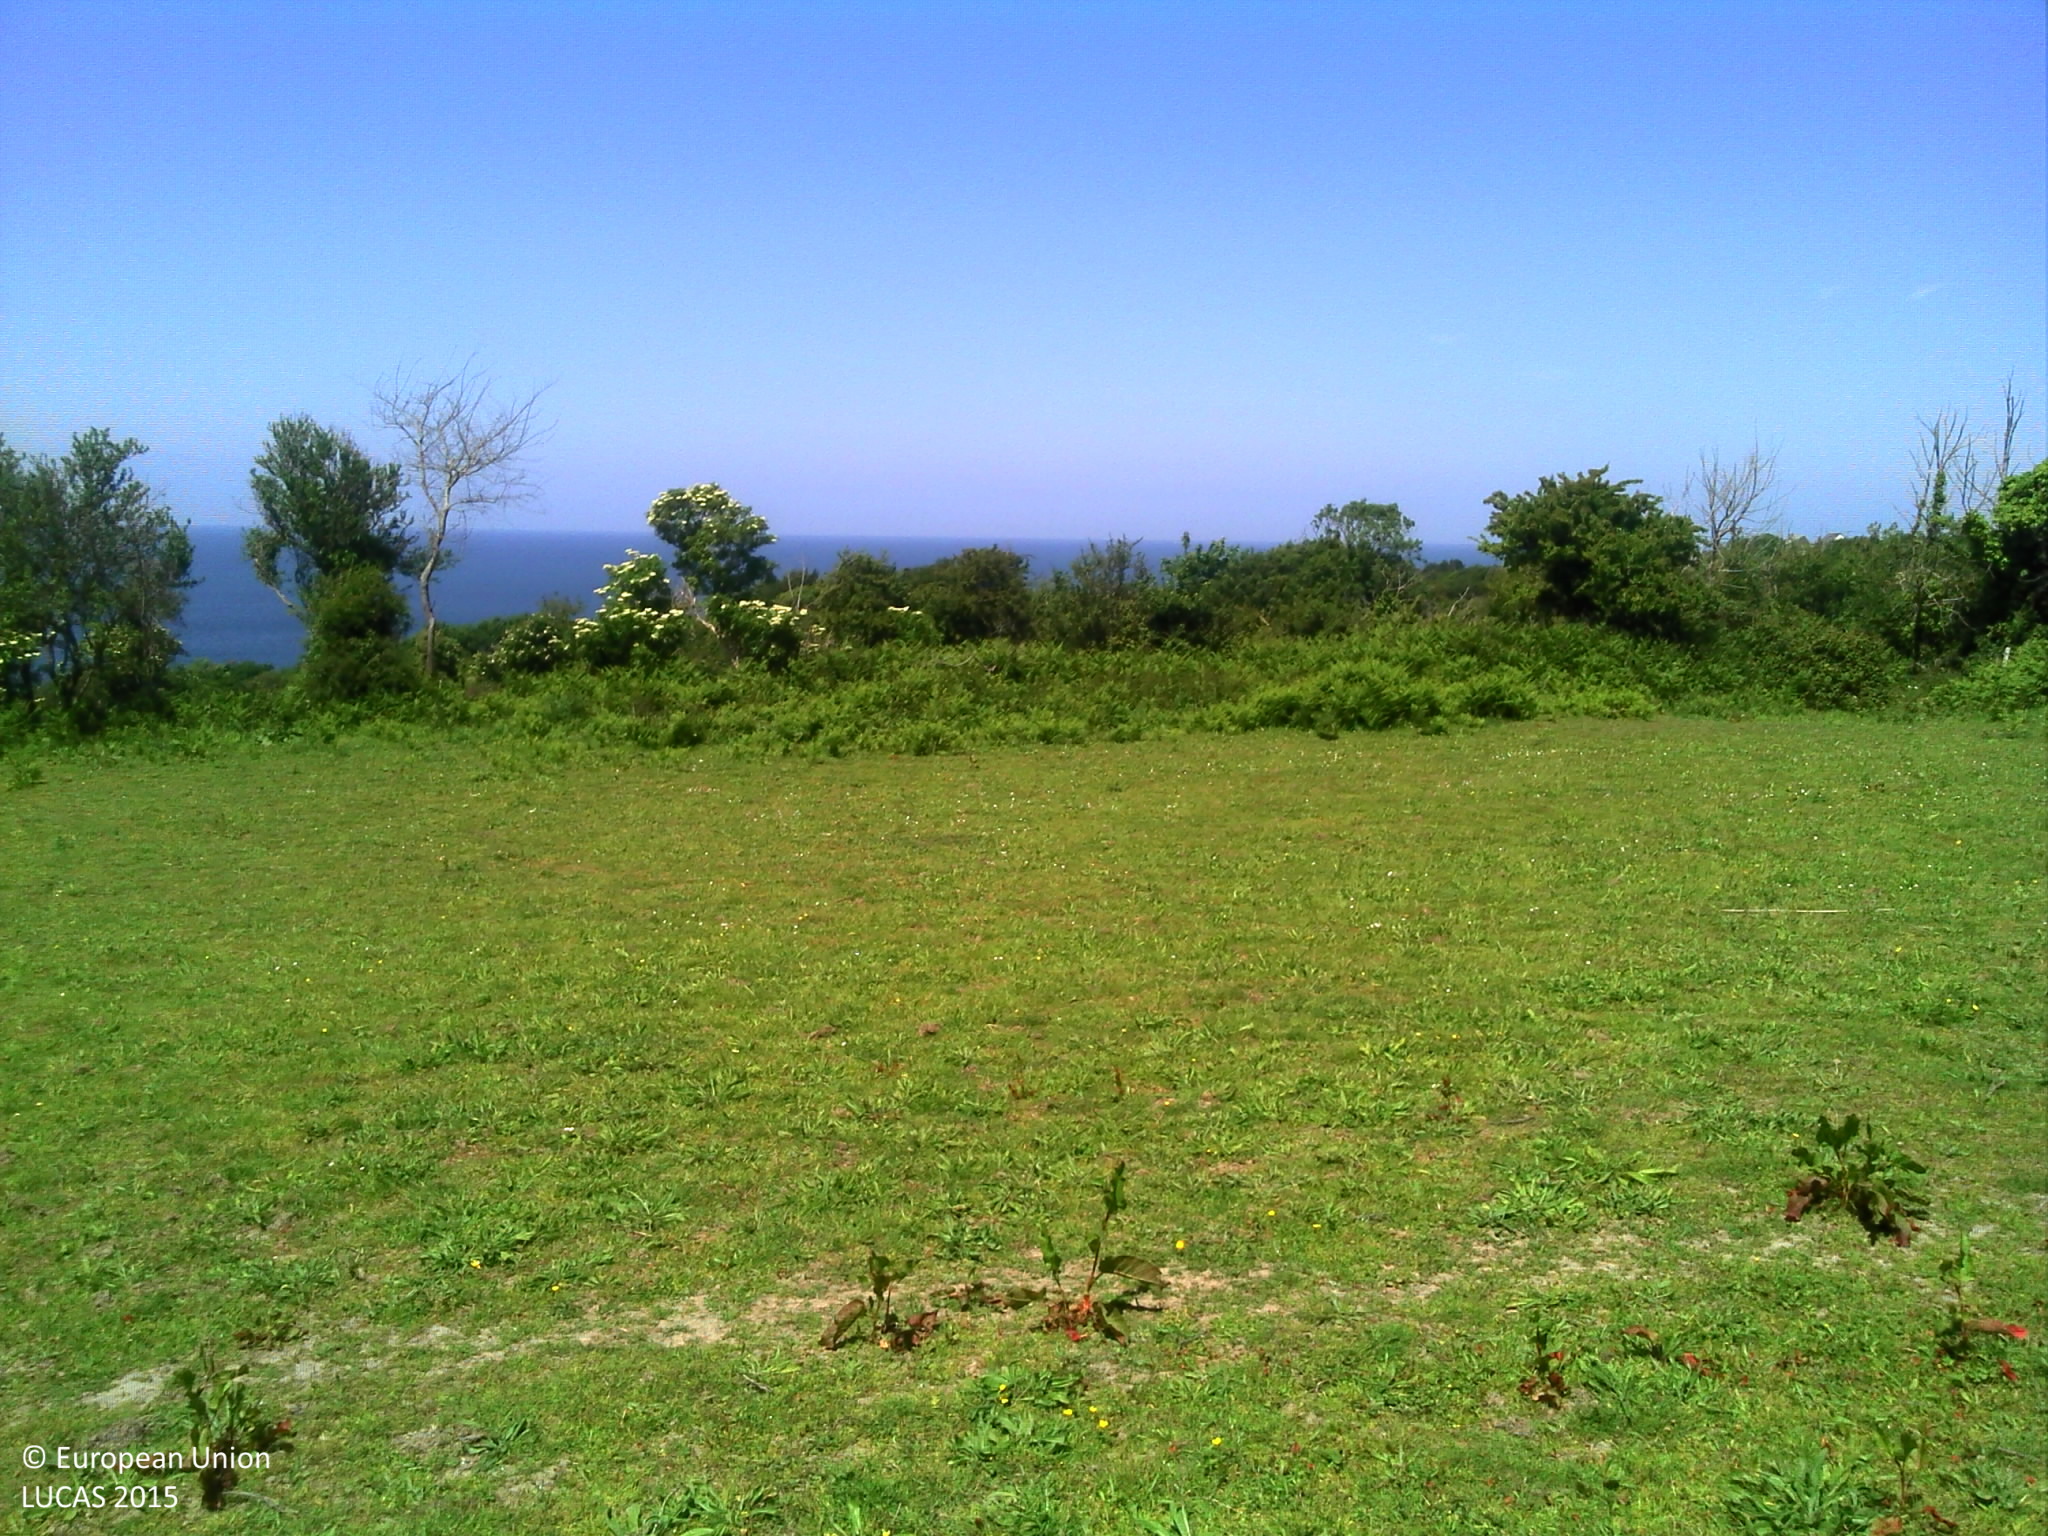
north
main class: Grassland
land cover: Grassland without tree/shrub cover
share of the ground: > 75 %
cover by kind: herbaceous plants 100 %
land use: Agriculture (excluding fallow land and kitchen gardens)
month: June
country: FR
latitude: 49.6541
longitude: -1.5051
